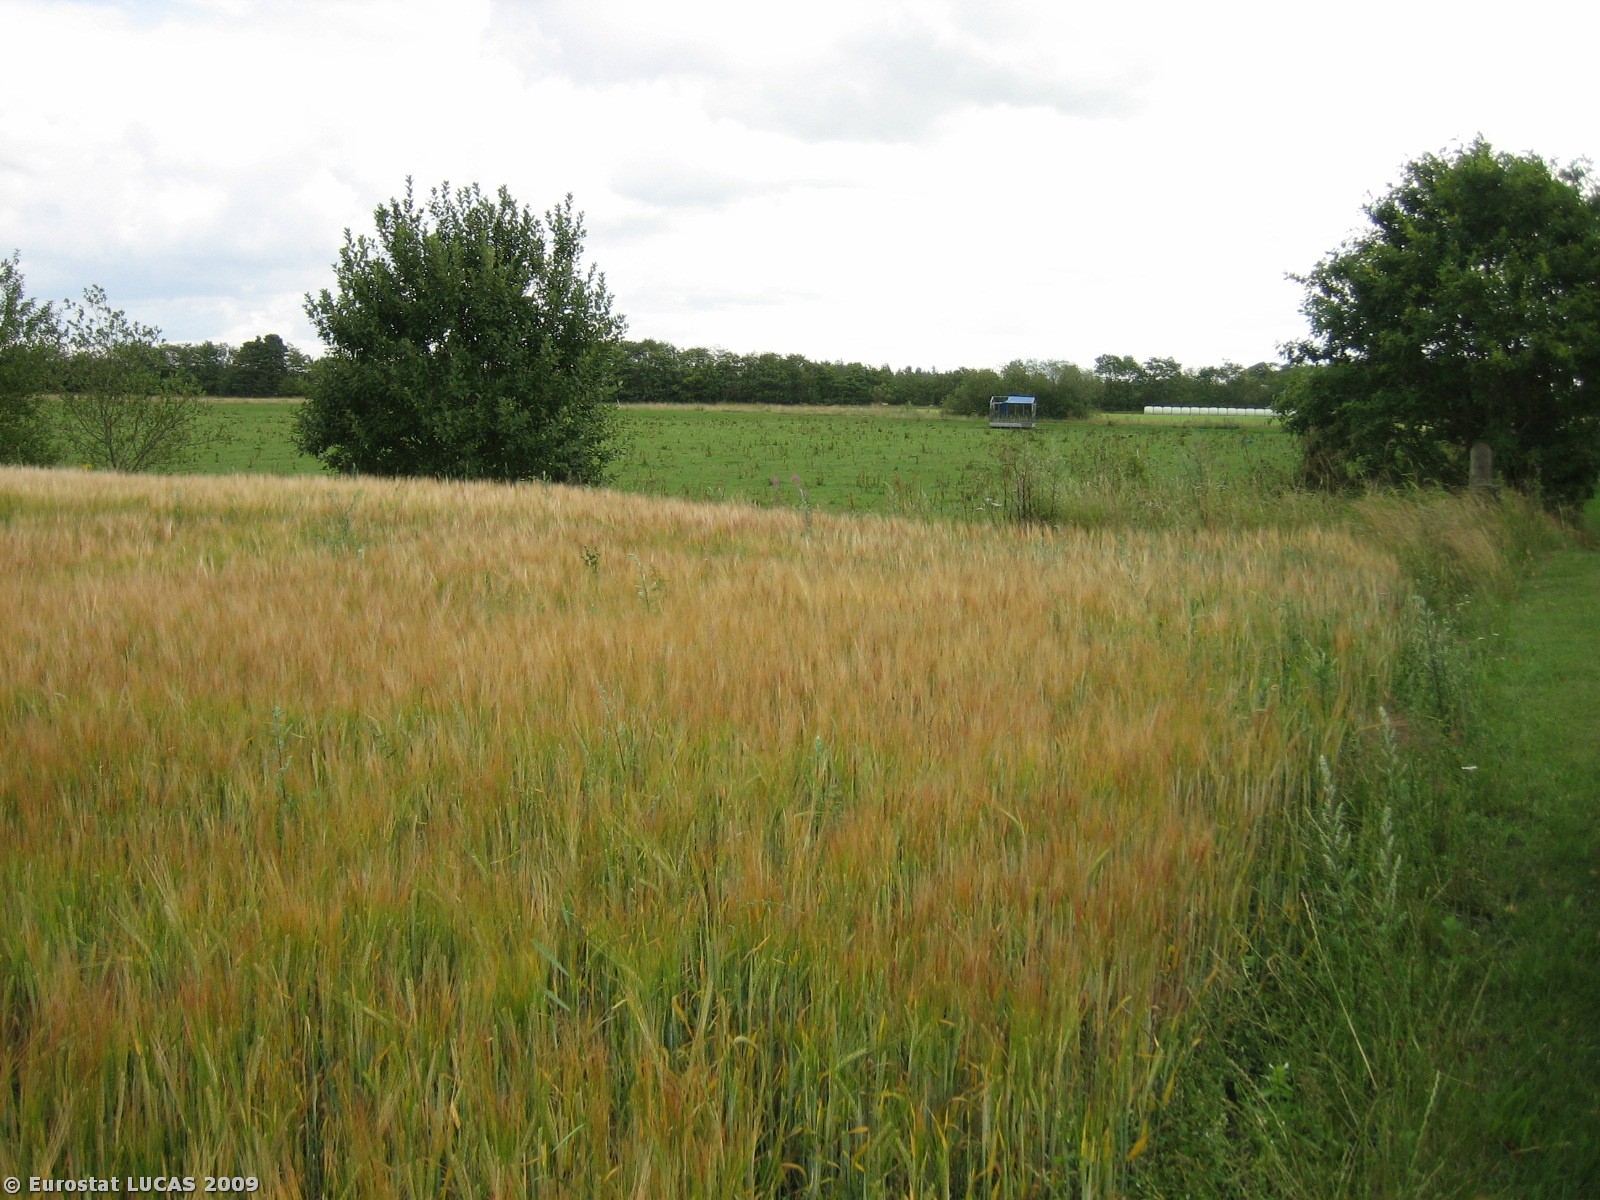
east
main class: Cropland
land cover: Barley
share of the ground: > 75 %
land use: Agriculture (excluding fallow land and kitchen gardens)
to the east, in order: Barley; Grassland without tree/shrub cover; Fences; Grassland without tree/shrub cover; Fences; Tracks; Fences; Grassland without tree/shrub cover
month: July
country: DK
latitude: 55.7883
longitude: 8.9963
